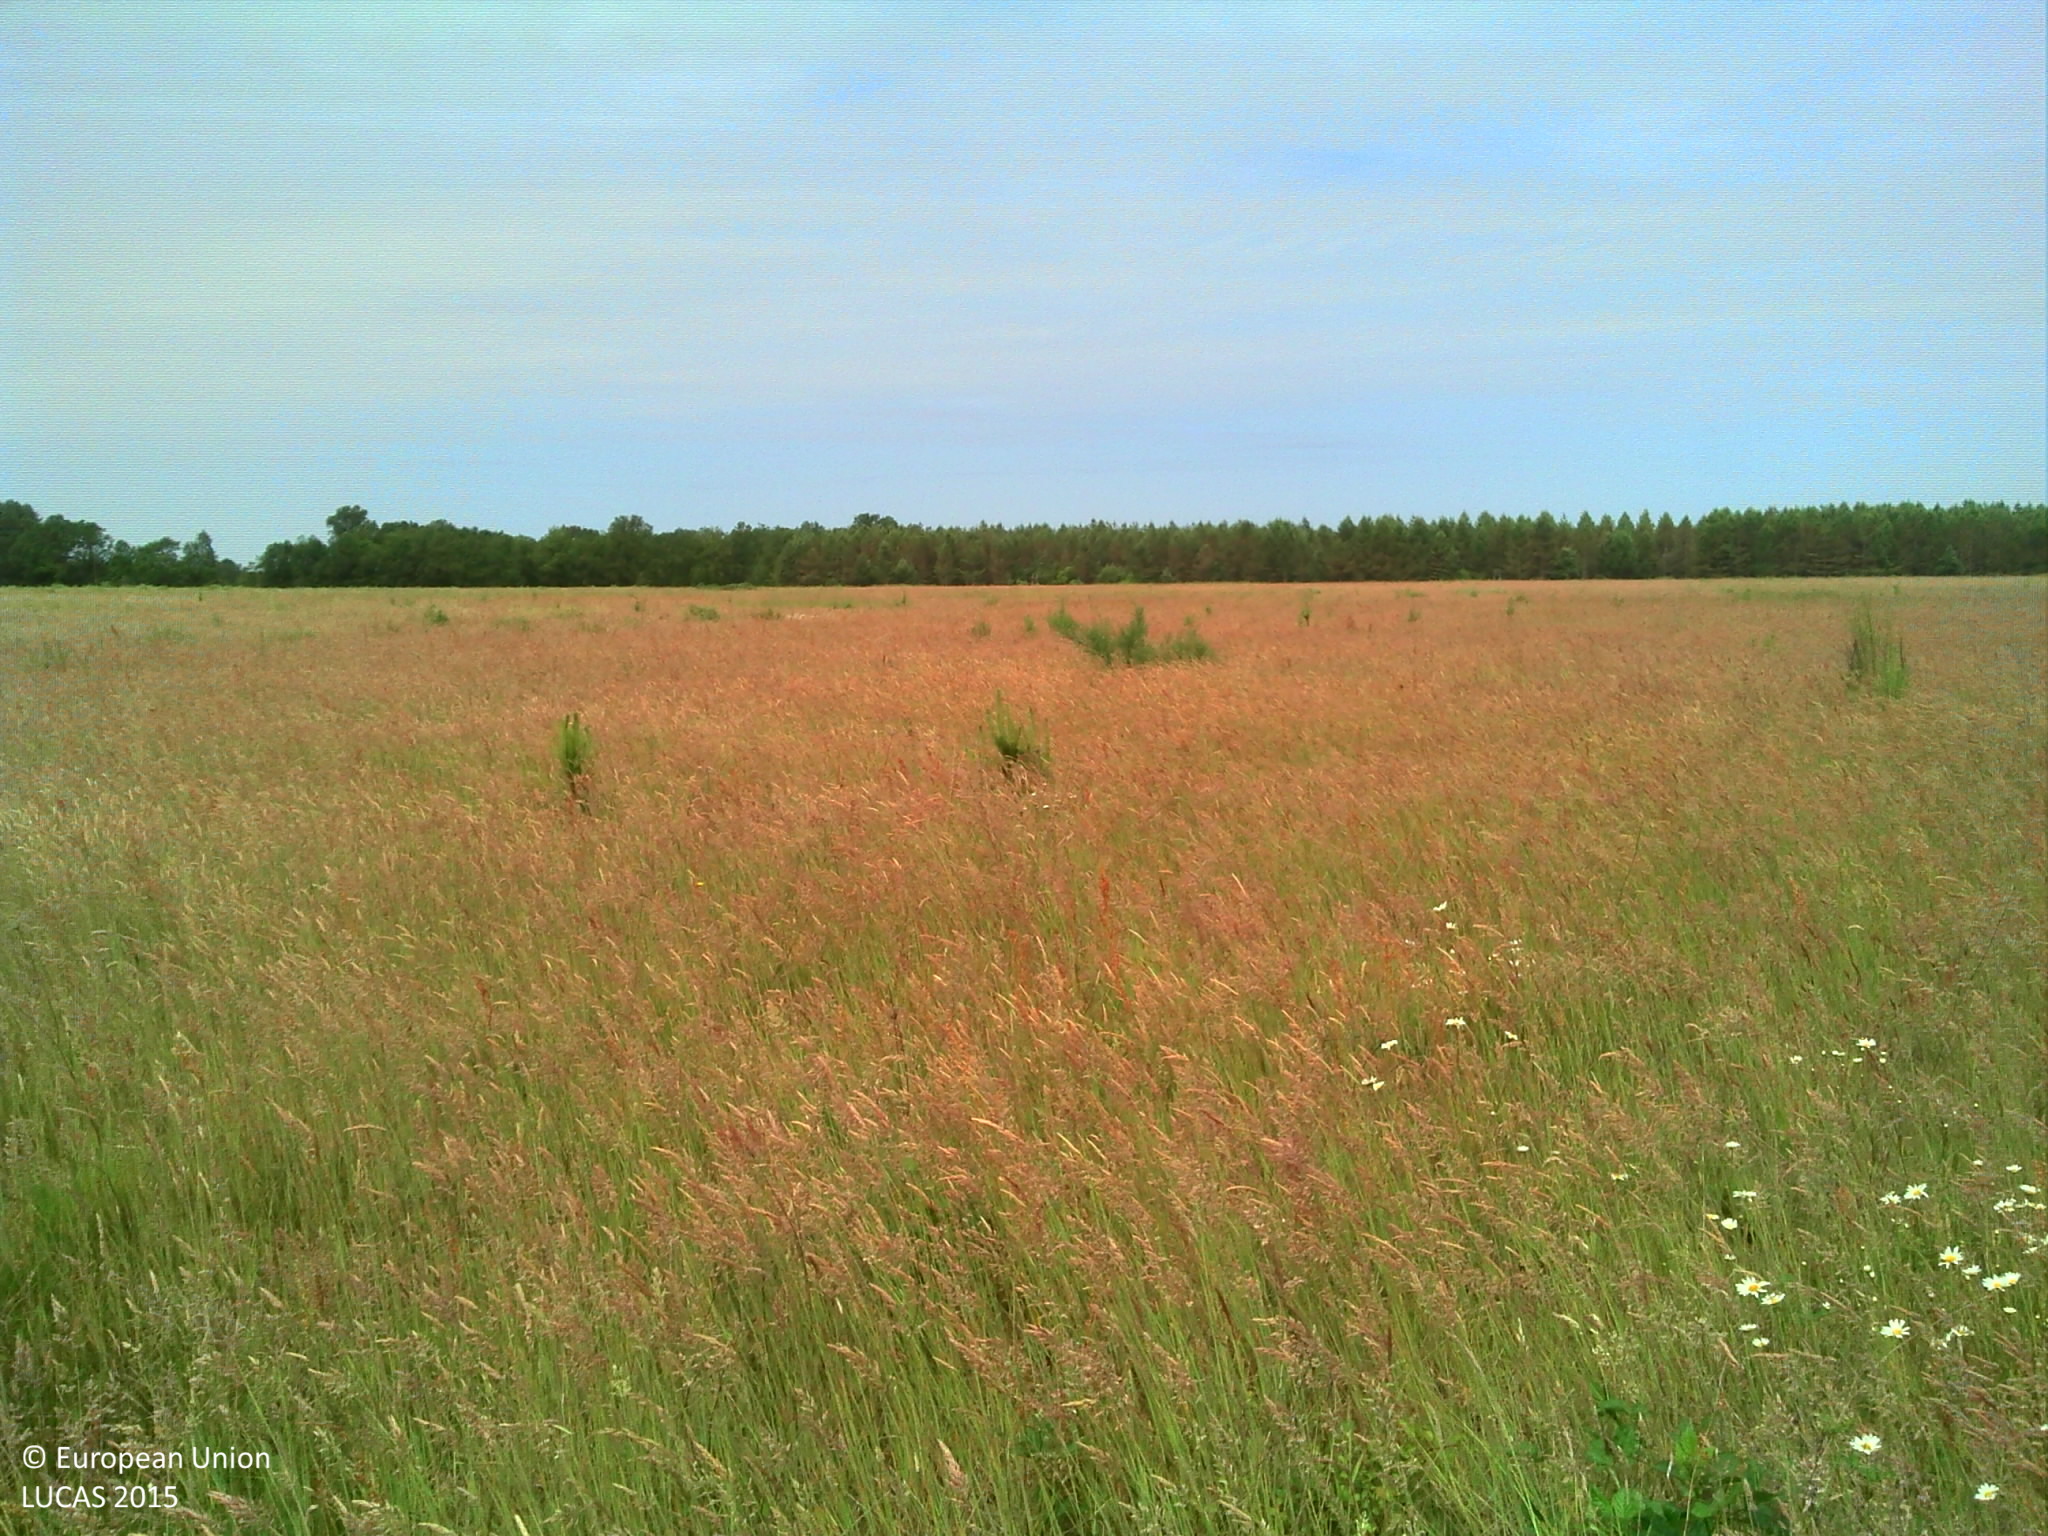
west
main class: Grassland
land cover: Grassland without tree/shrub cover
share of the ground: > 75 %
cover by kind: herbaceous plants 95 %, shrubs 5 %
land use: Agriculture (excluding fallow land and kitchen gardens)
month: June
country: FR
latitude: 47.4455
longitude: 1.5390
